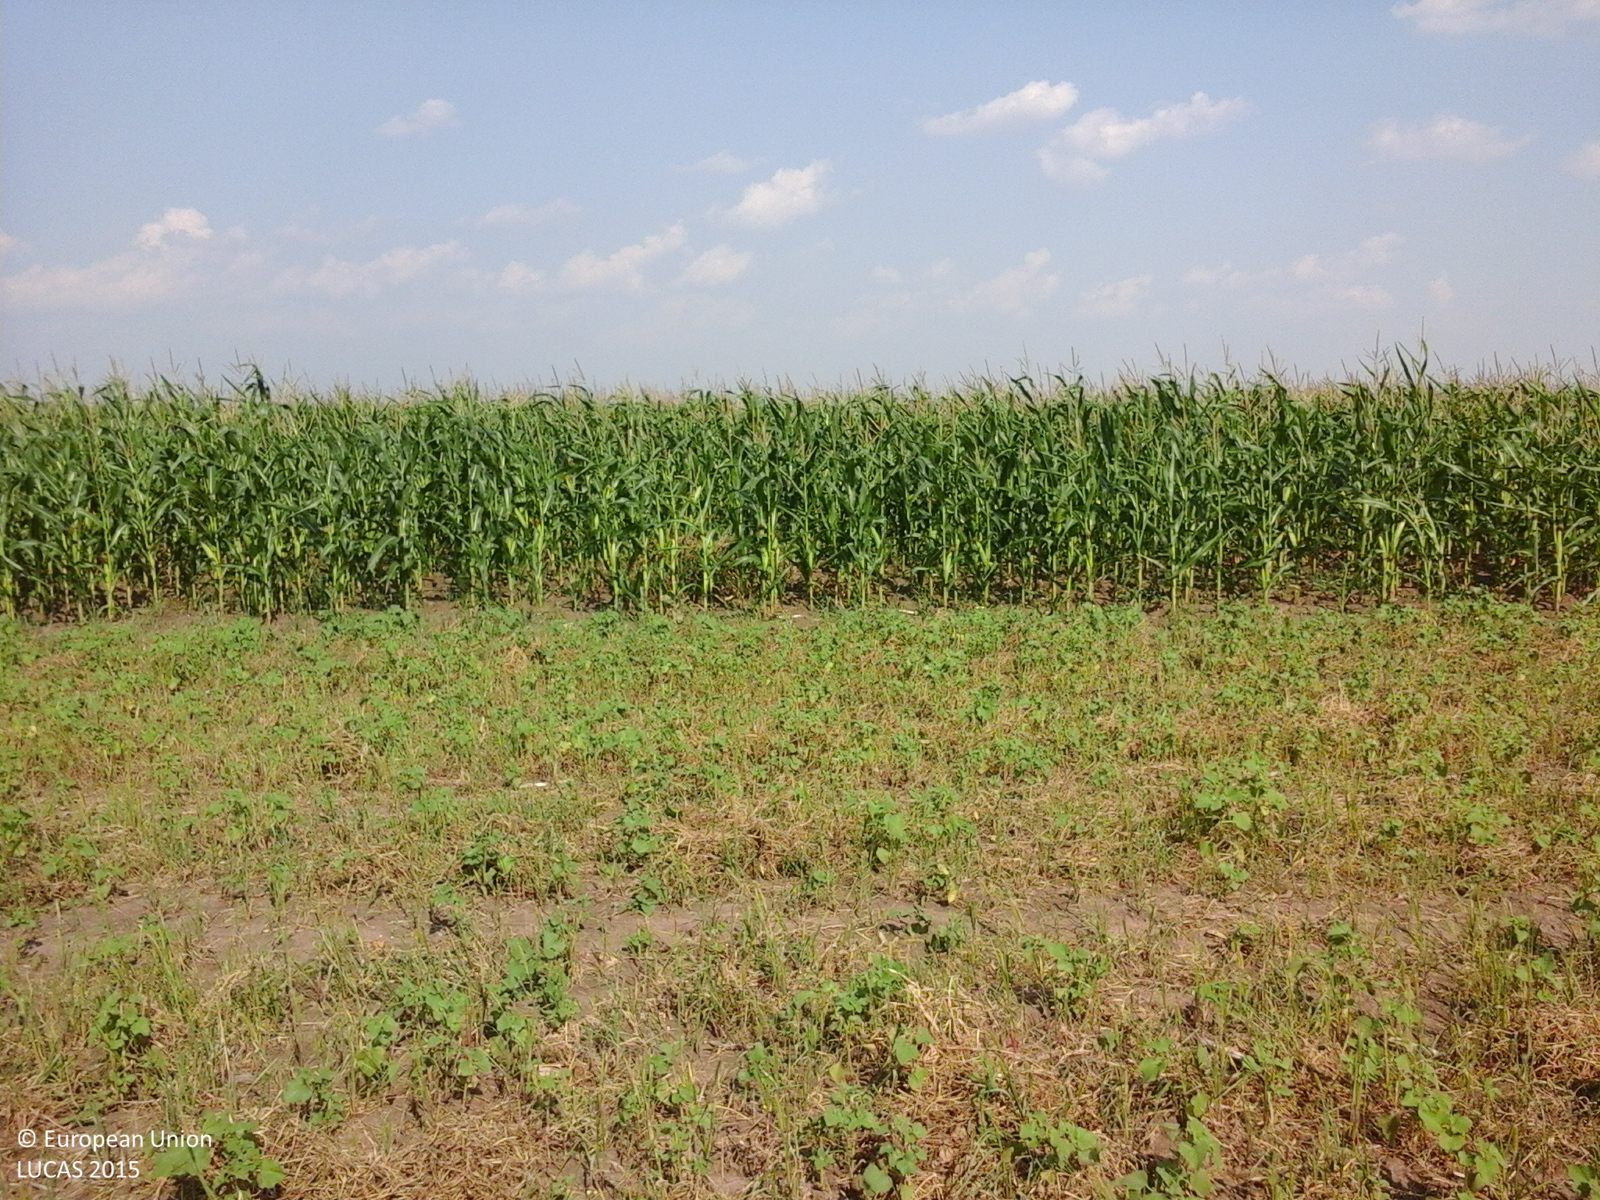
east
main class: Cropland
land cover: Maize
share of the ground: > 75 %
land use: Agriculture (excluding fallow land and kitchen gardens)
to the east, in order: Maize; Dry pulses; Maize; Other fresh vegetables; Maize
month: July
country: RO
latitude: 45.9814
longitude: 27.4935
